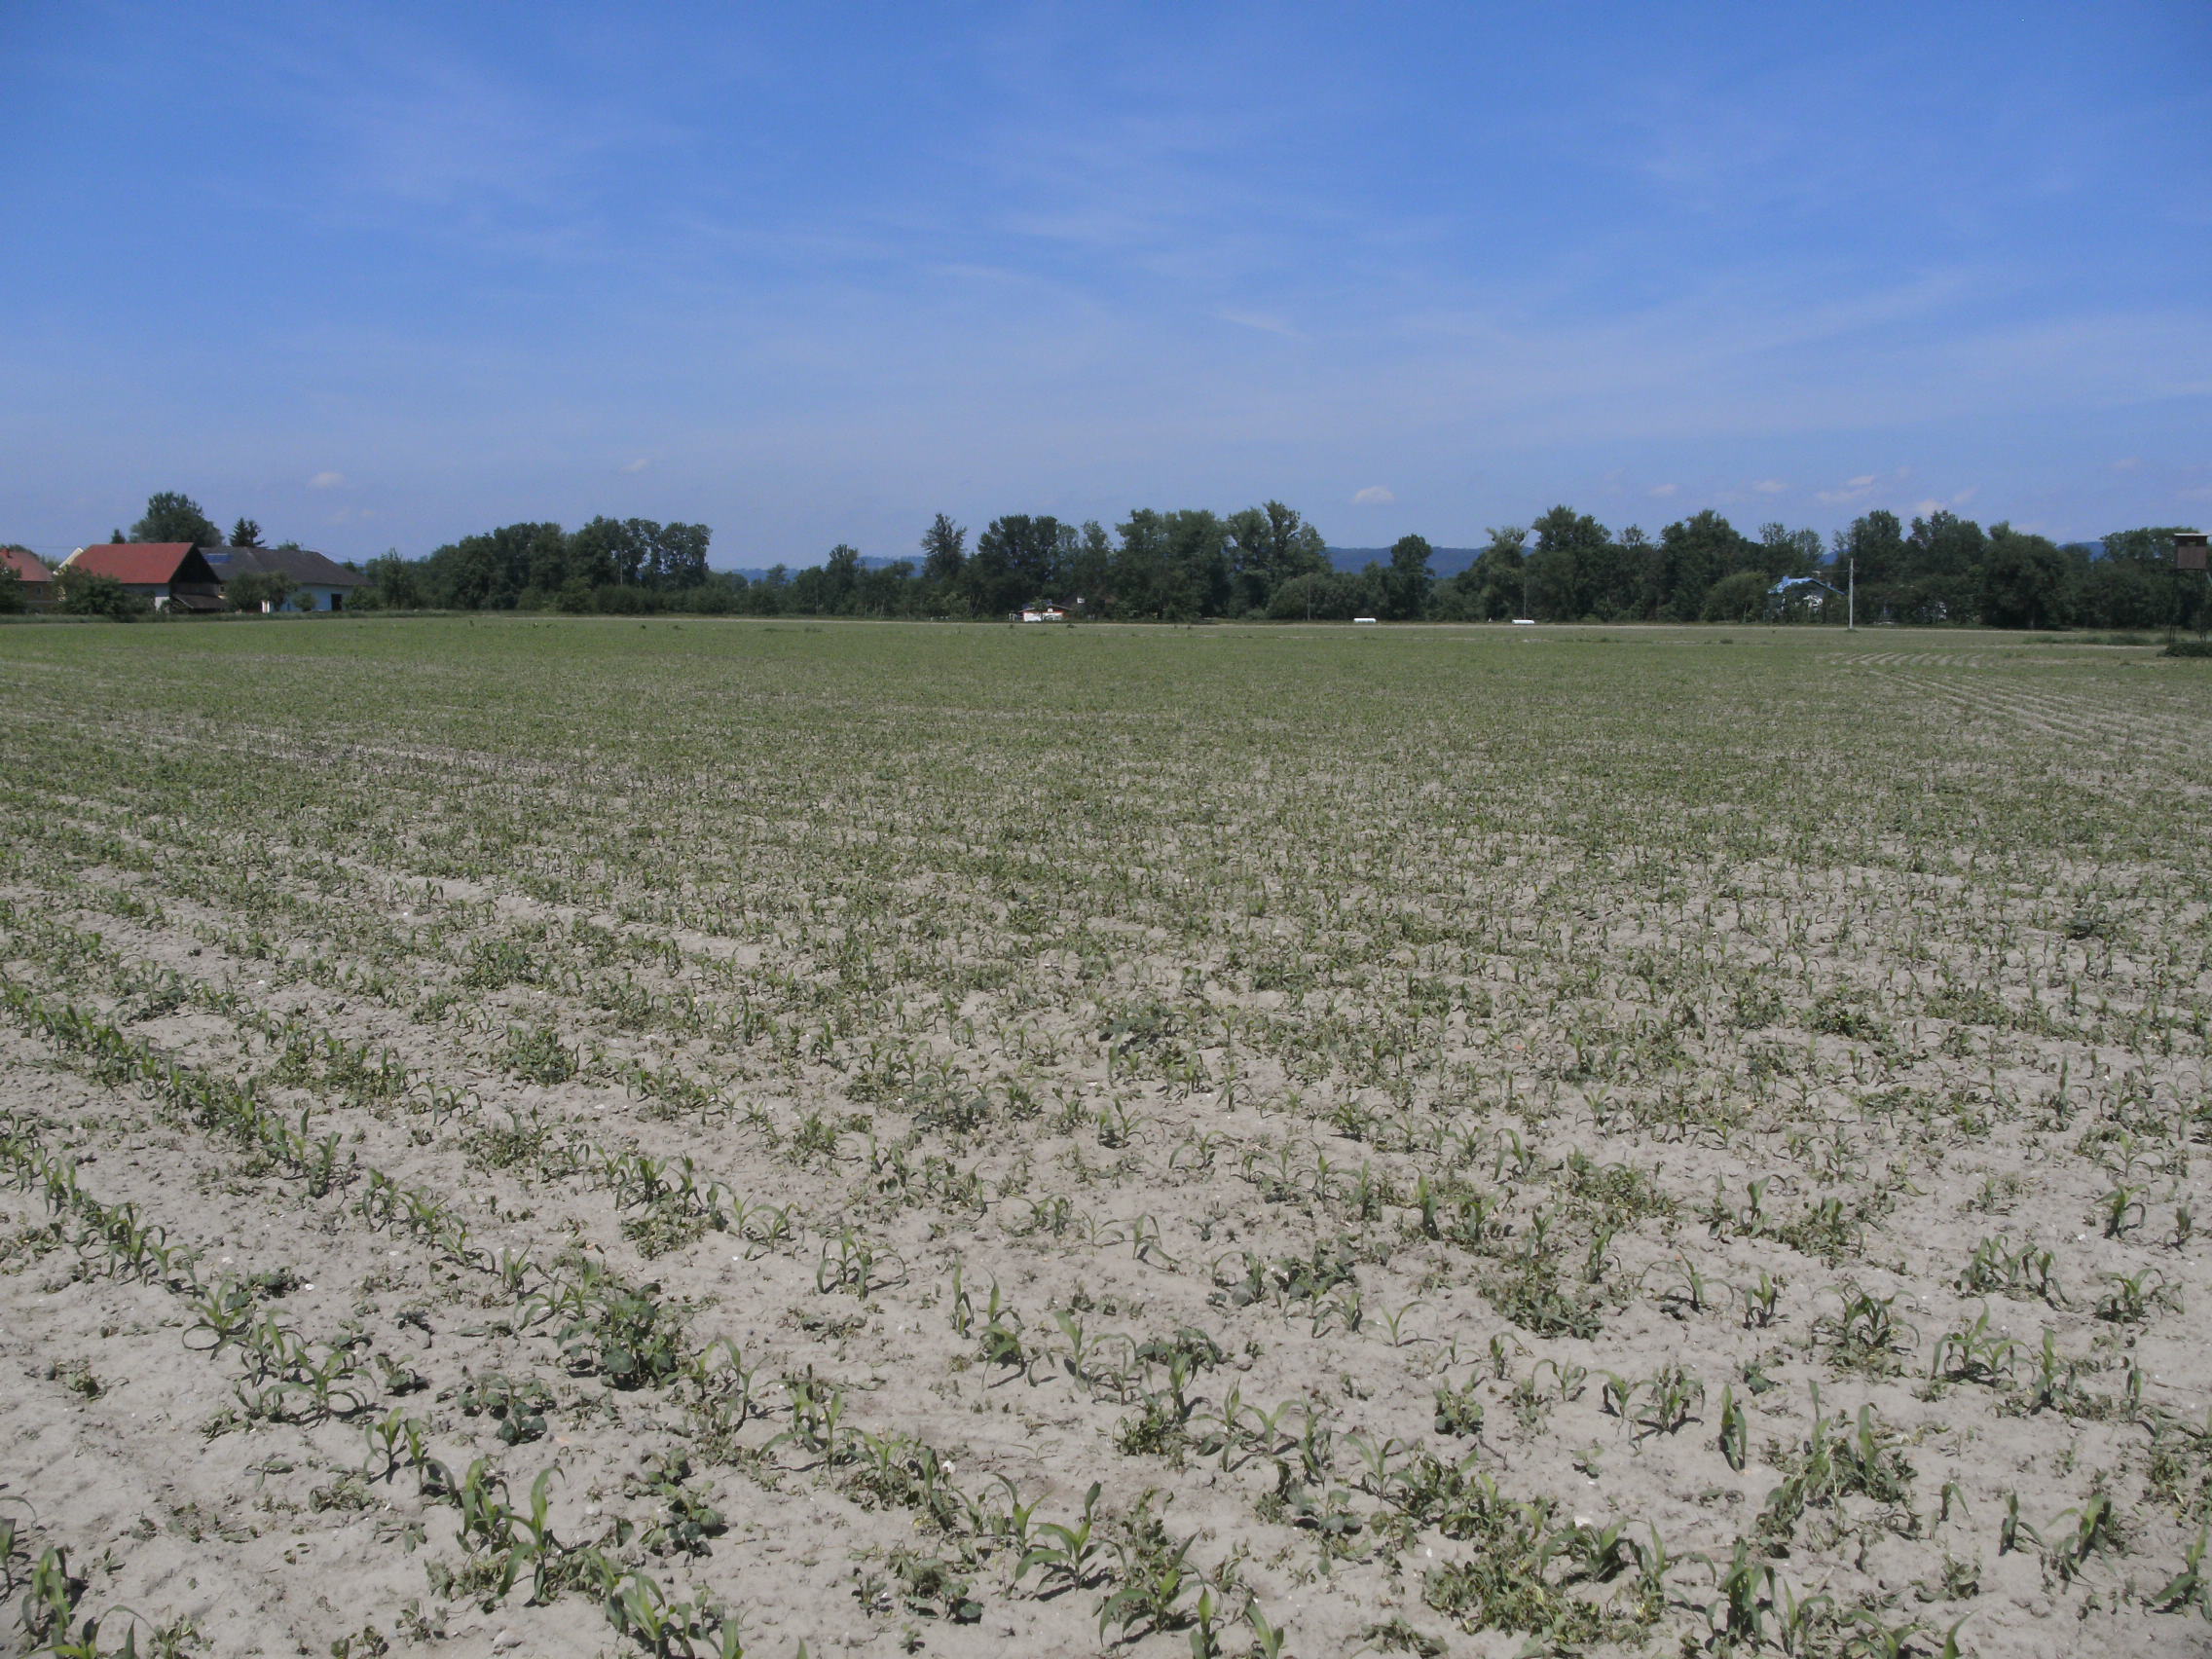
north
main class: Cropland
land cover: Maize
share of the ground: 10 - 25 %
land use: Agriculture (excluding fallow land and kitchen gardens)
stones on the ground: < 10 %
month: May
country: AT
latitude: 48.3120
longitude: 14.0315
